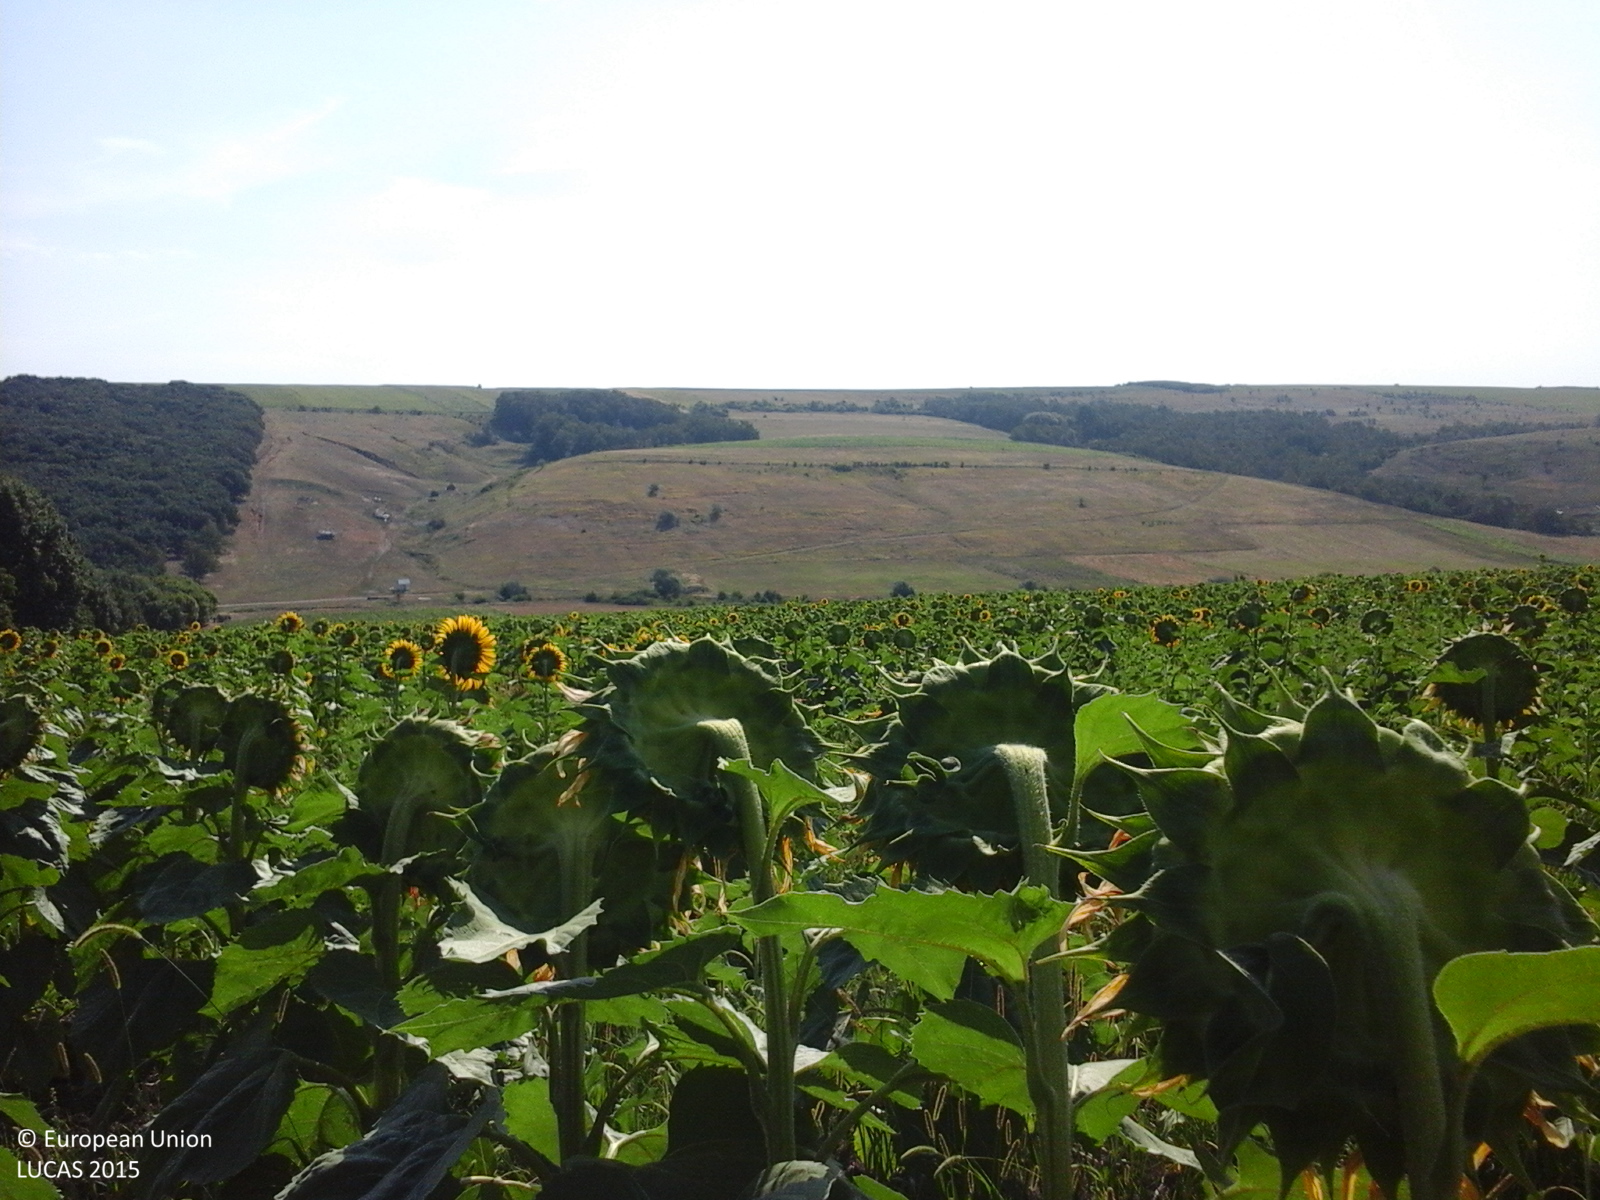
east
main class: Cropland
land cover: Sunflower
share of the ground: > 75 %
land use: Agriculture (excluding fallow land and kitchen gardens)
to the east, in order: Sunflower; Maize; Common wheat
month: July
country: RO
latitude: 46.0393
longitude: 27.8060
